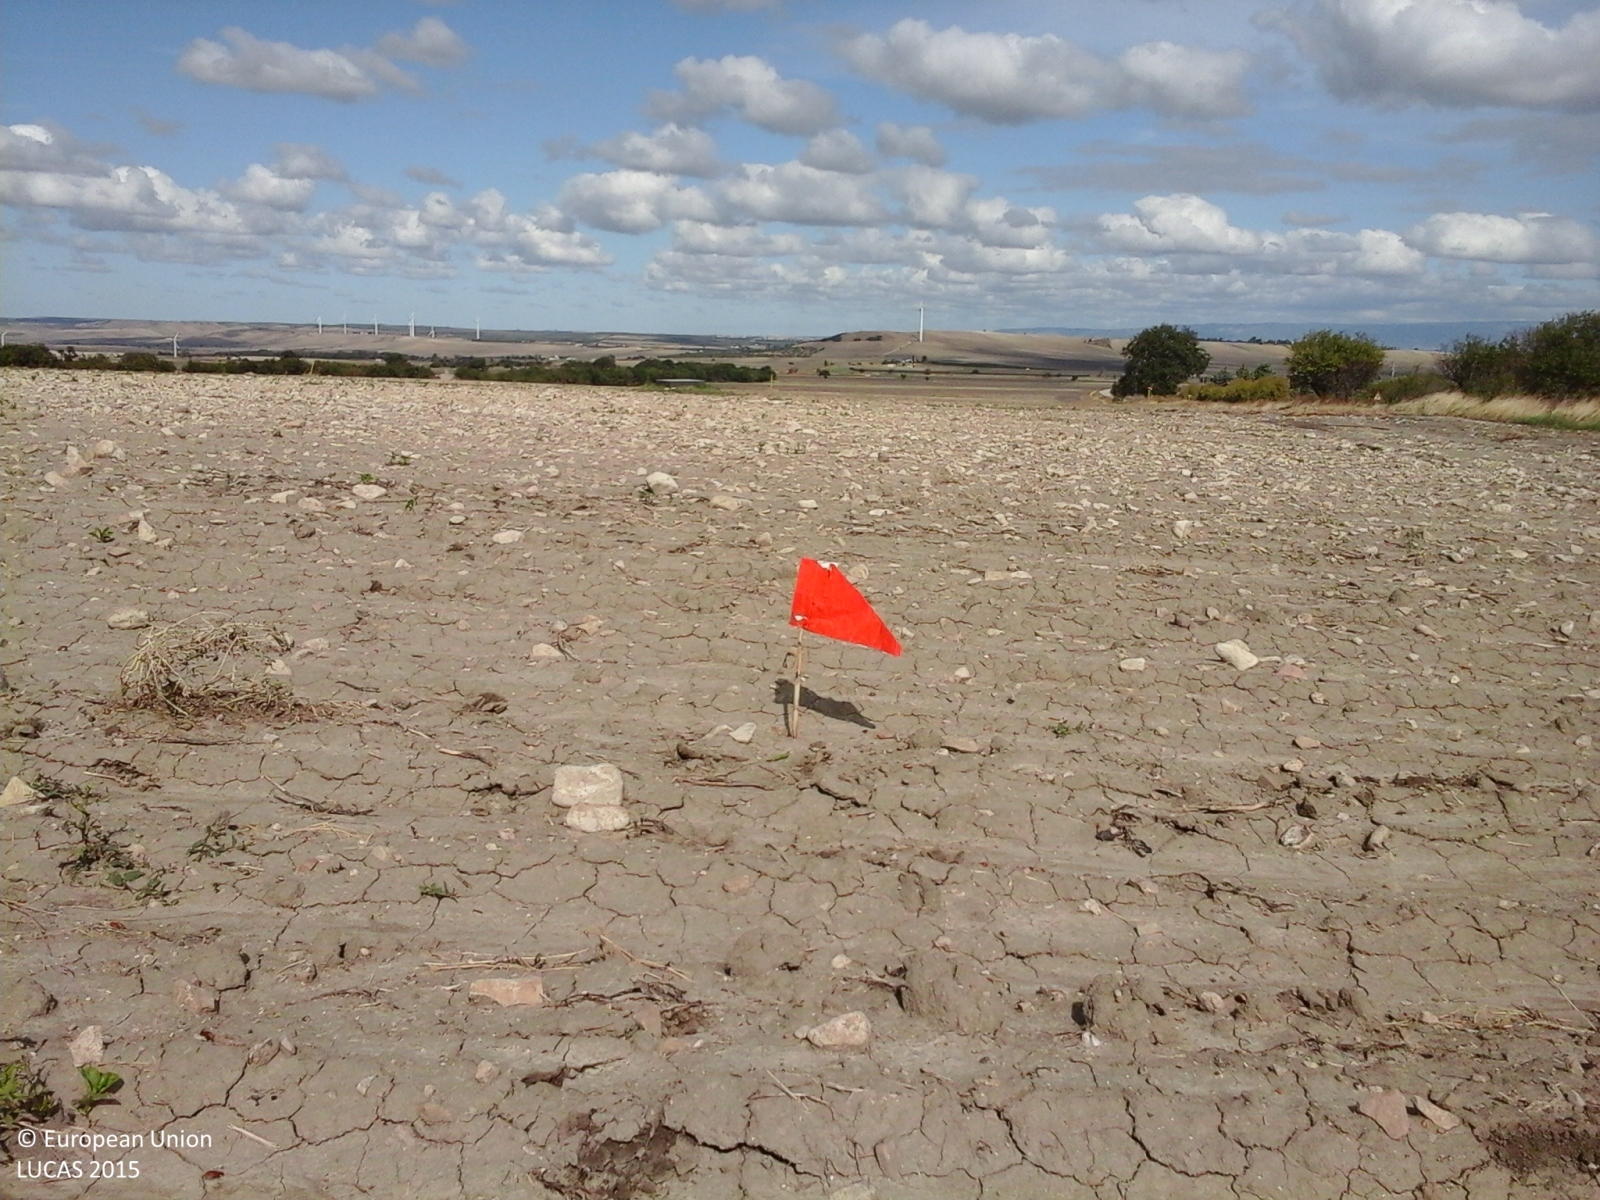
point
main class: Cropland
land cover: Dry pulses
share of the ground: > 75 %
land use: Agriculture (excluding fallow land and kitchen gardens)
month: September
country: IT
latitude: 41.5984
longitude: 15.1780
